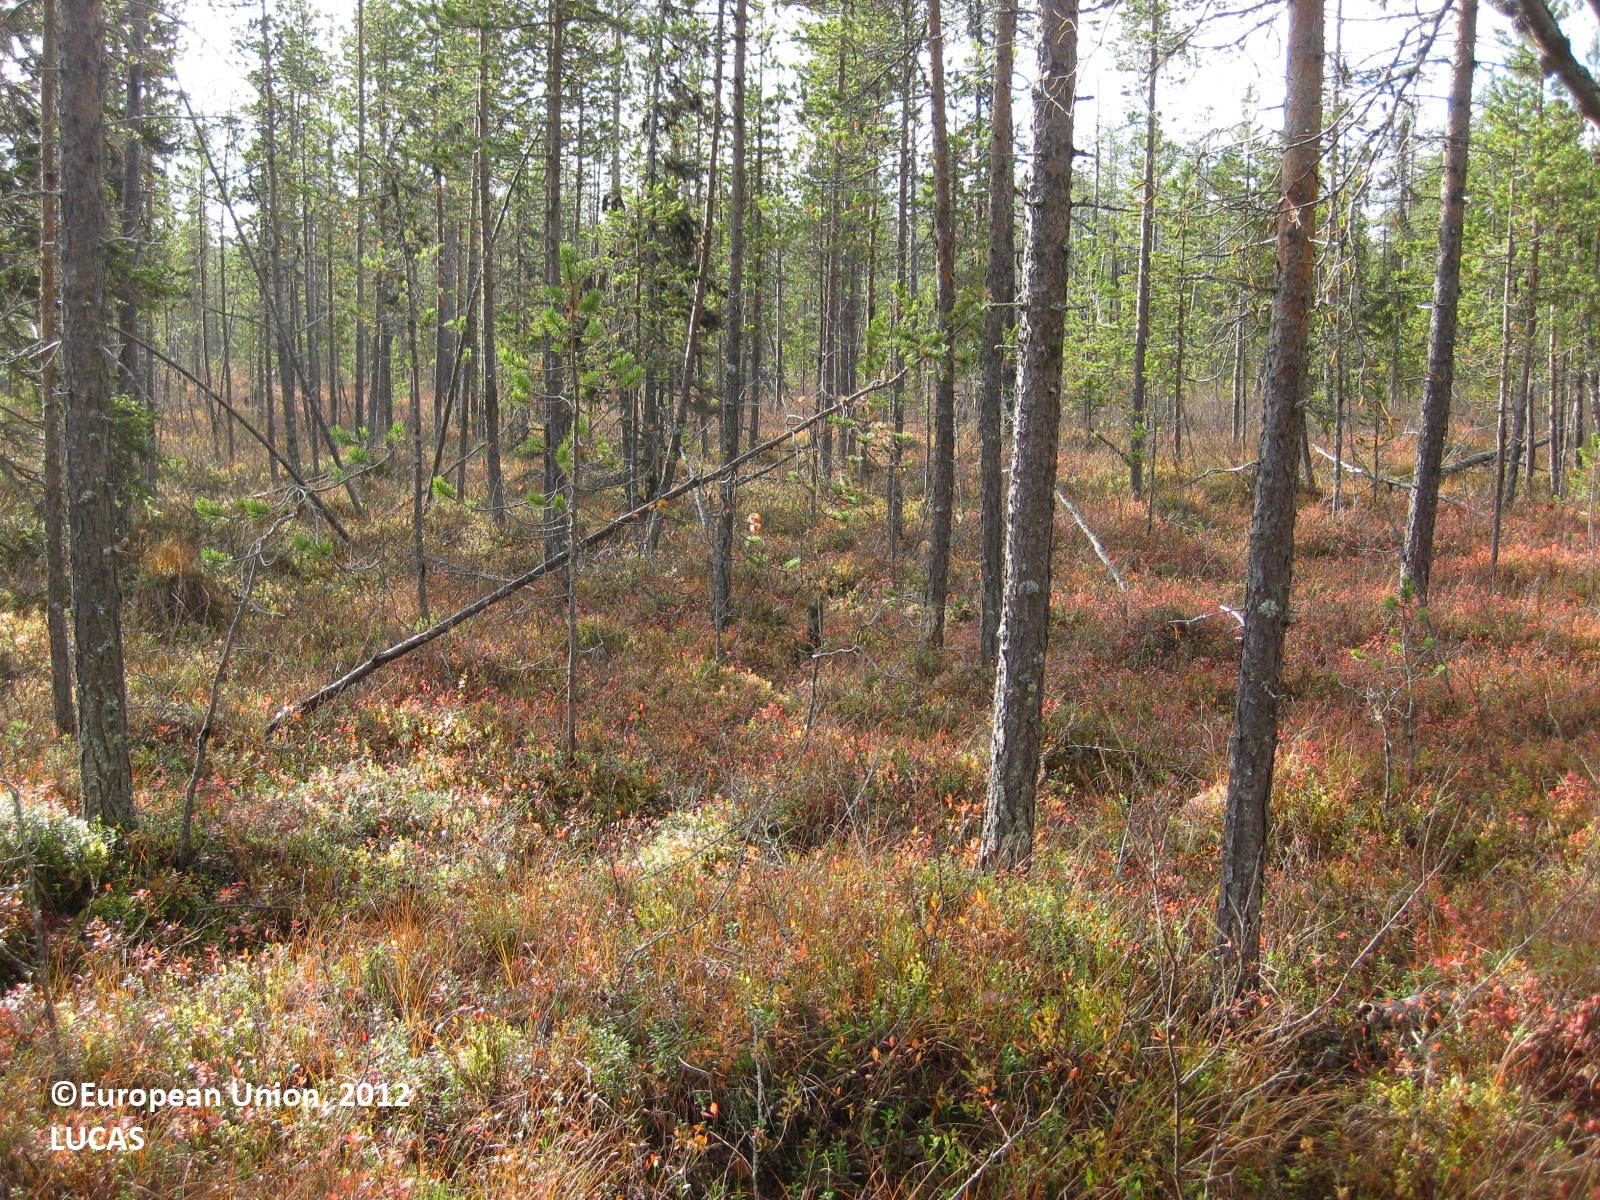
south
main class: Woodland
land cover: Other coniferous woodland
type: boreal forest
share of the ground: > 75 %
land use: Forestry
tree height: > 5 m
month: September
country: FI
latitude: 67.9836
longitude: 23.7090
